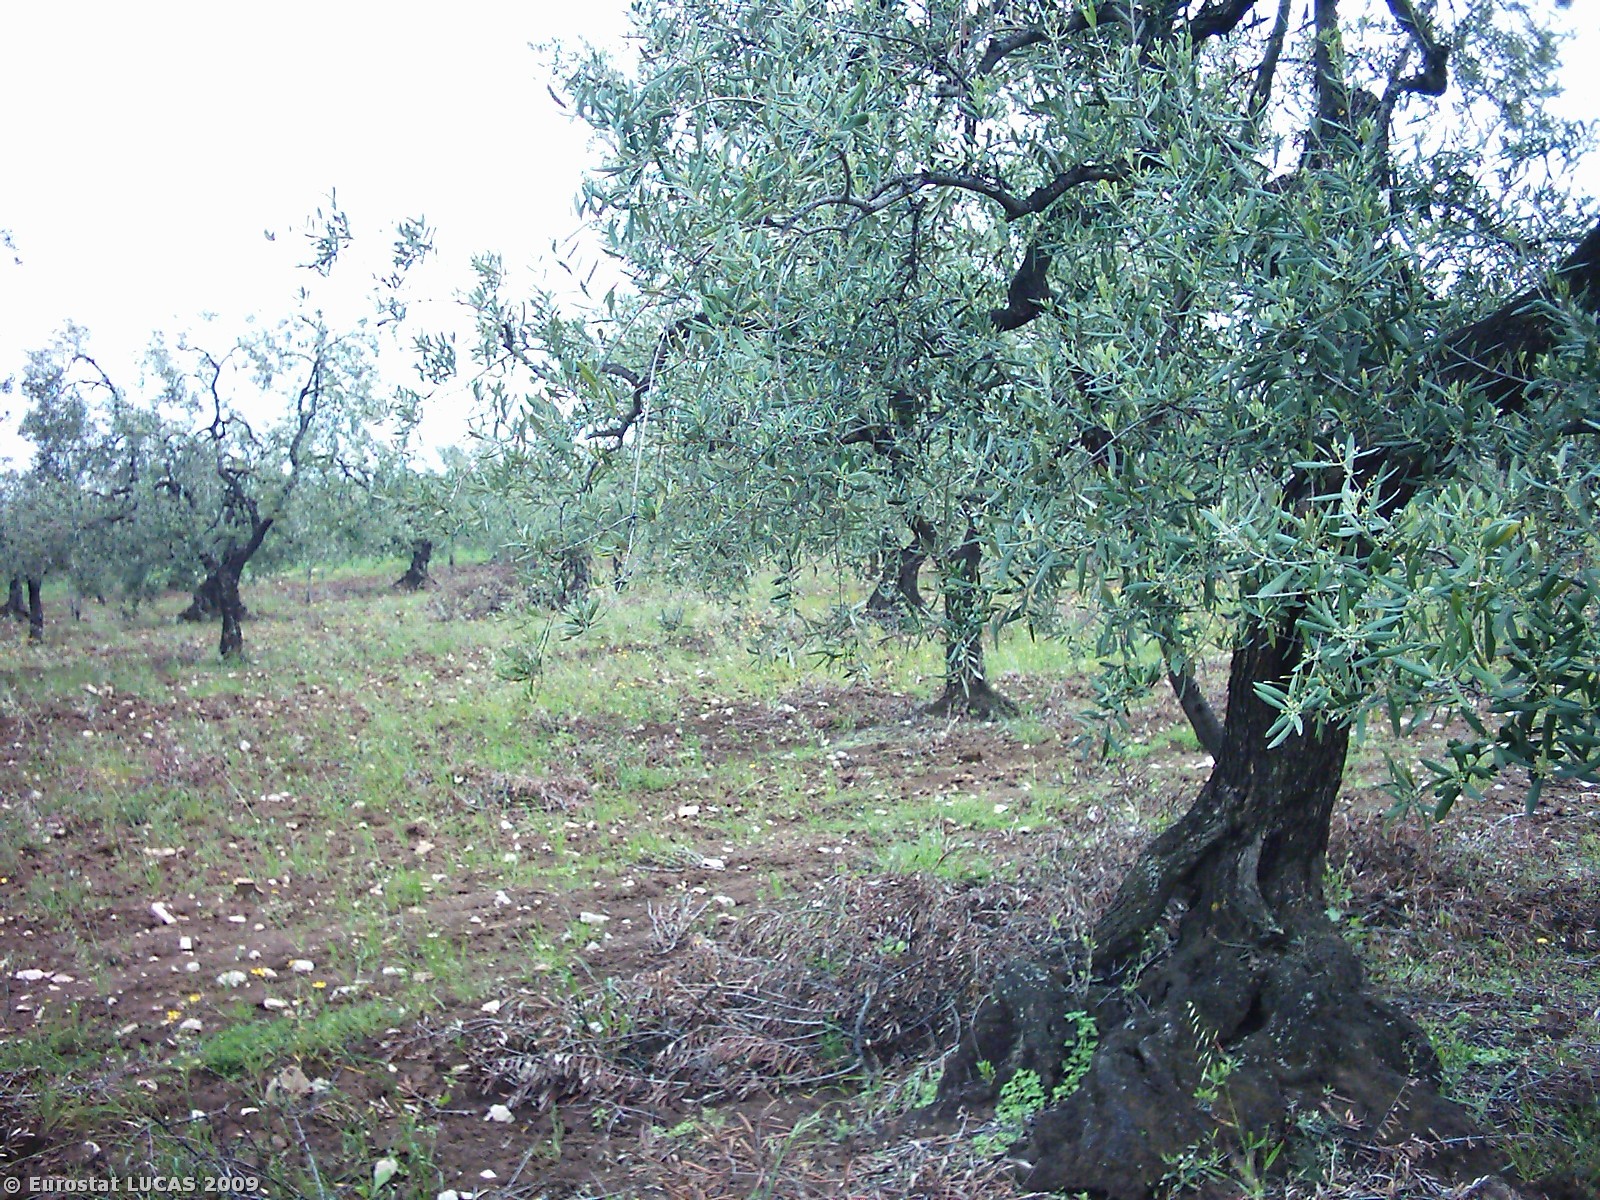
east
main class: Cropland
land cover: Olive groves
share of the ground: 25 - 50 %
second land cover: Bare land
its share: 50 - 75 %
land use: Agriculture (excluding fallow land and kitchen gardens)
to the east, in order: Olive groves; Bare land; Dry stone walls; Olive groves; Dry stone walls; Other fresh vegetables; Paved roads, cycling and walking lanes; Other fresh vegetables; Dry stone walls; Olive groves; Tracks; Olive groves
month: April
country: IT
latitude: 41.2217
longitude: 16.3618
